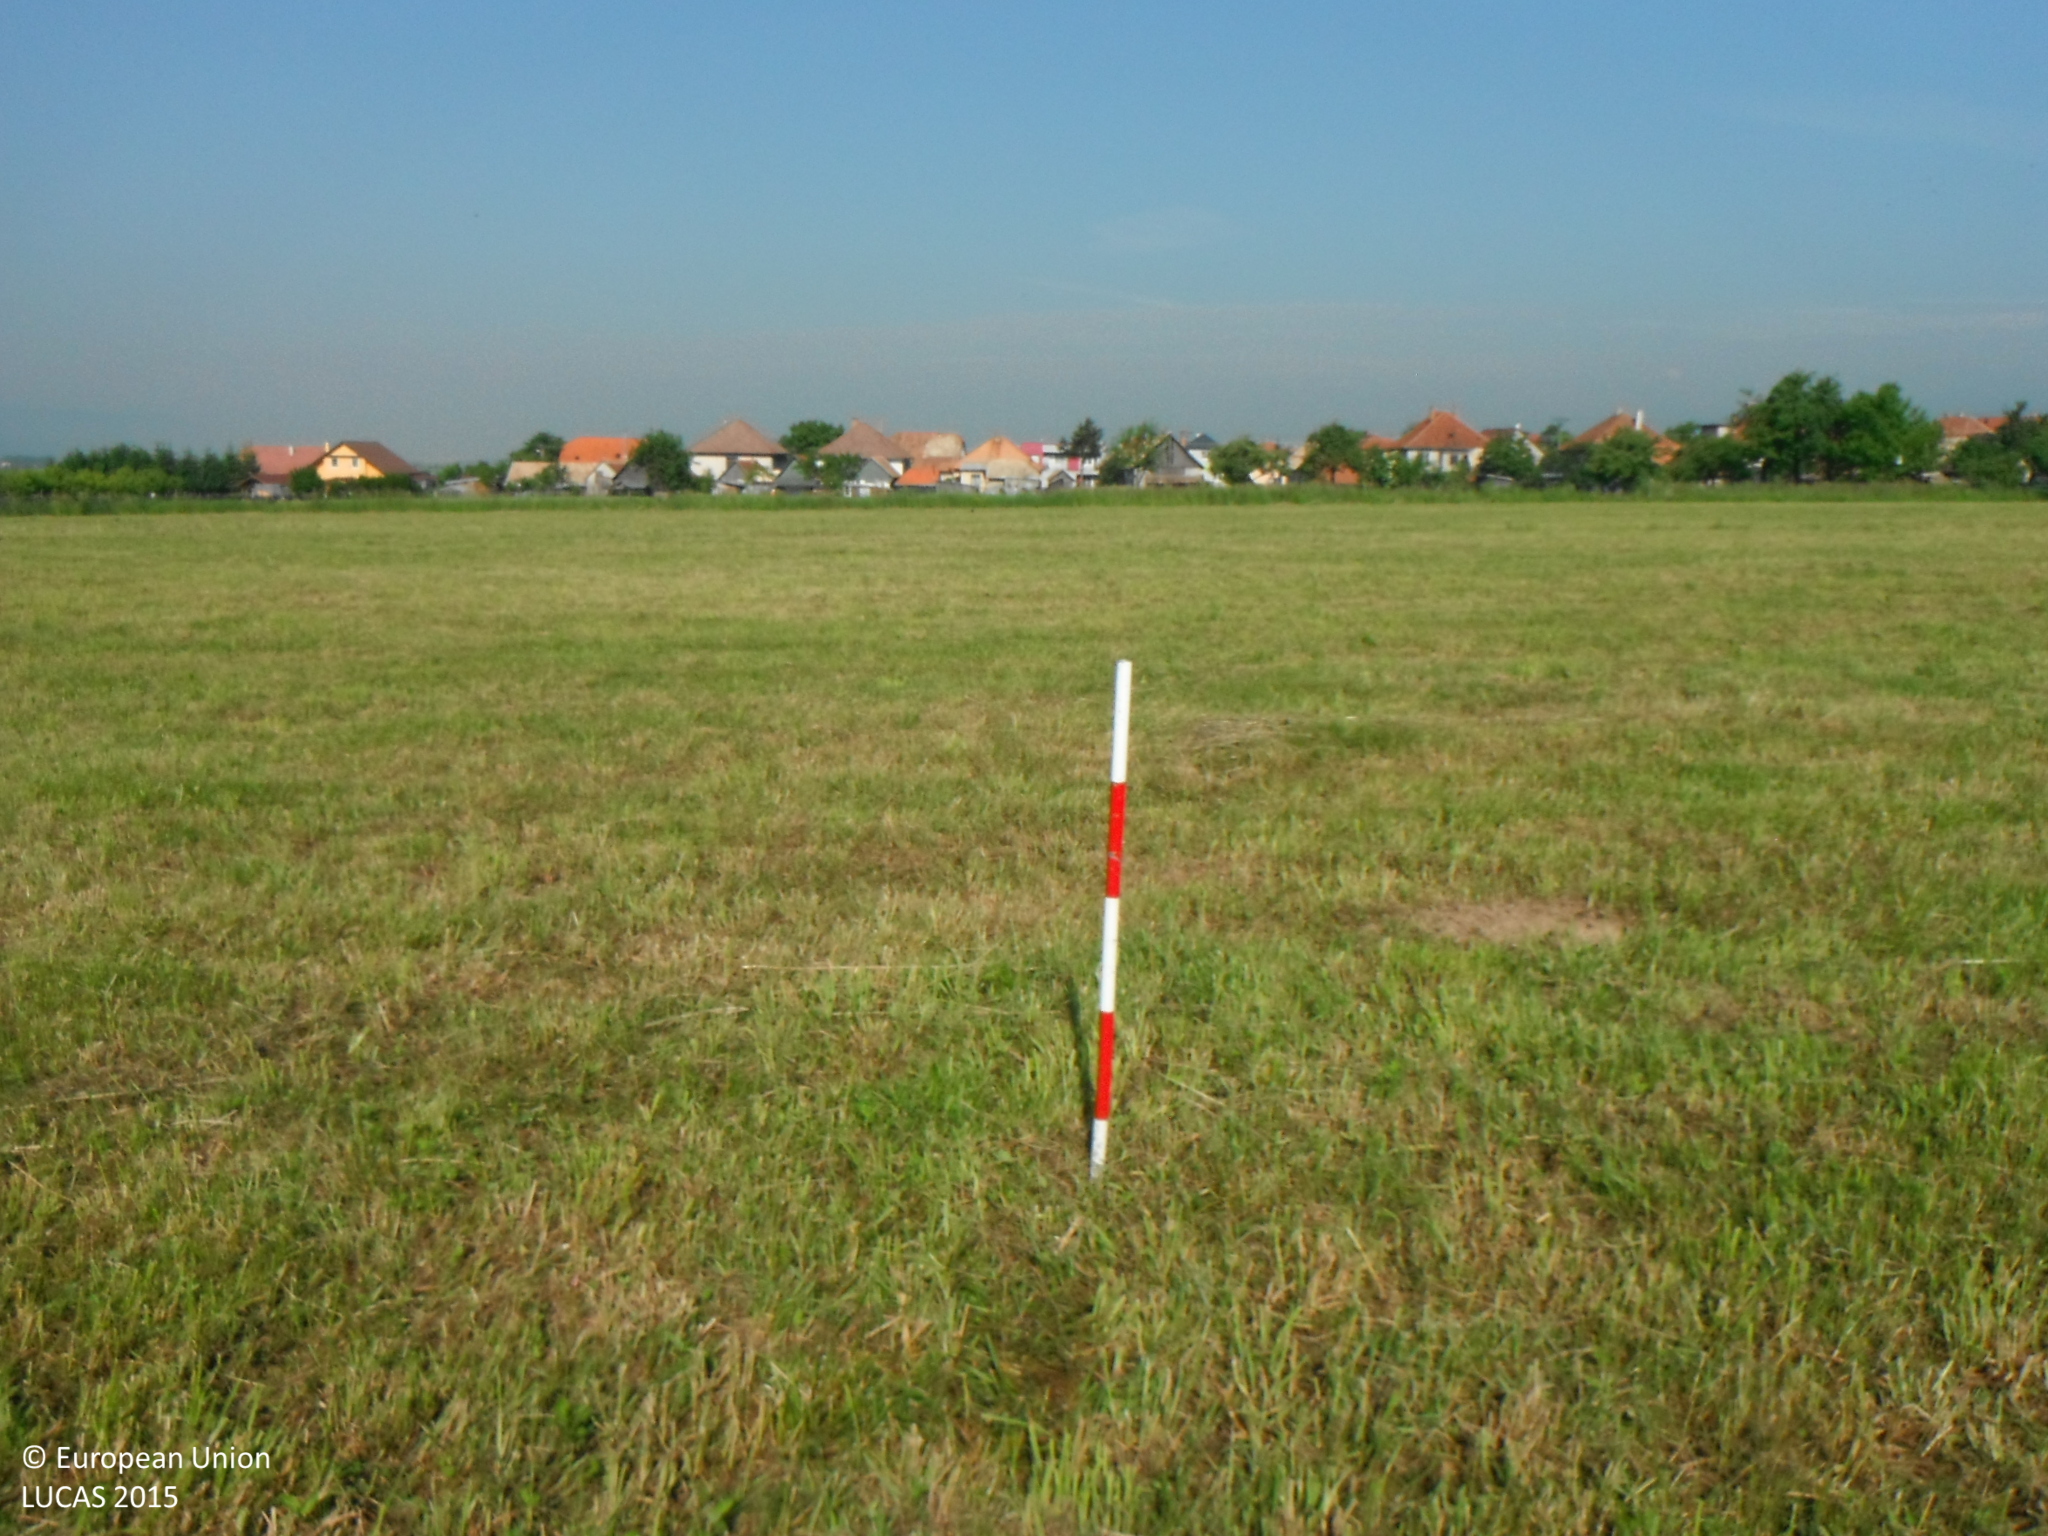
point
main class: Grassland
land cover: Grassland without tree/shrub cover
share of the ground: > 75 %
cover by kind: herbaceous plants 100 %
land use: Agriculture (excluding fallow land and kitchen gardens)
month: June
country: SK
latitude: 48.5849
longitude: 19.3642
